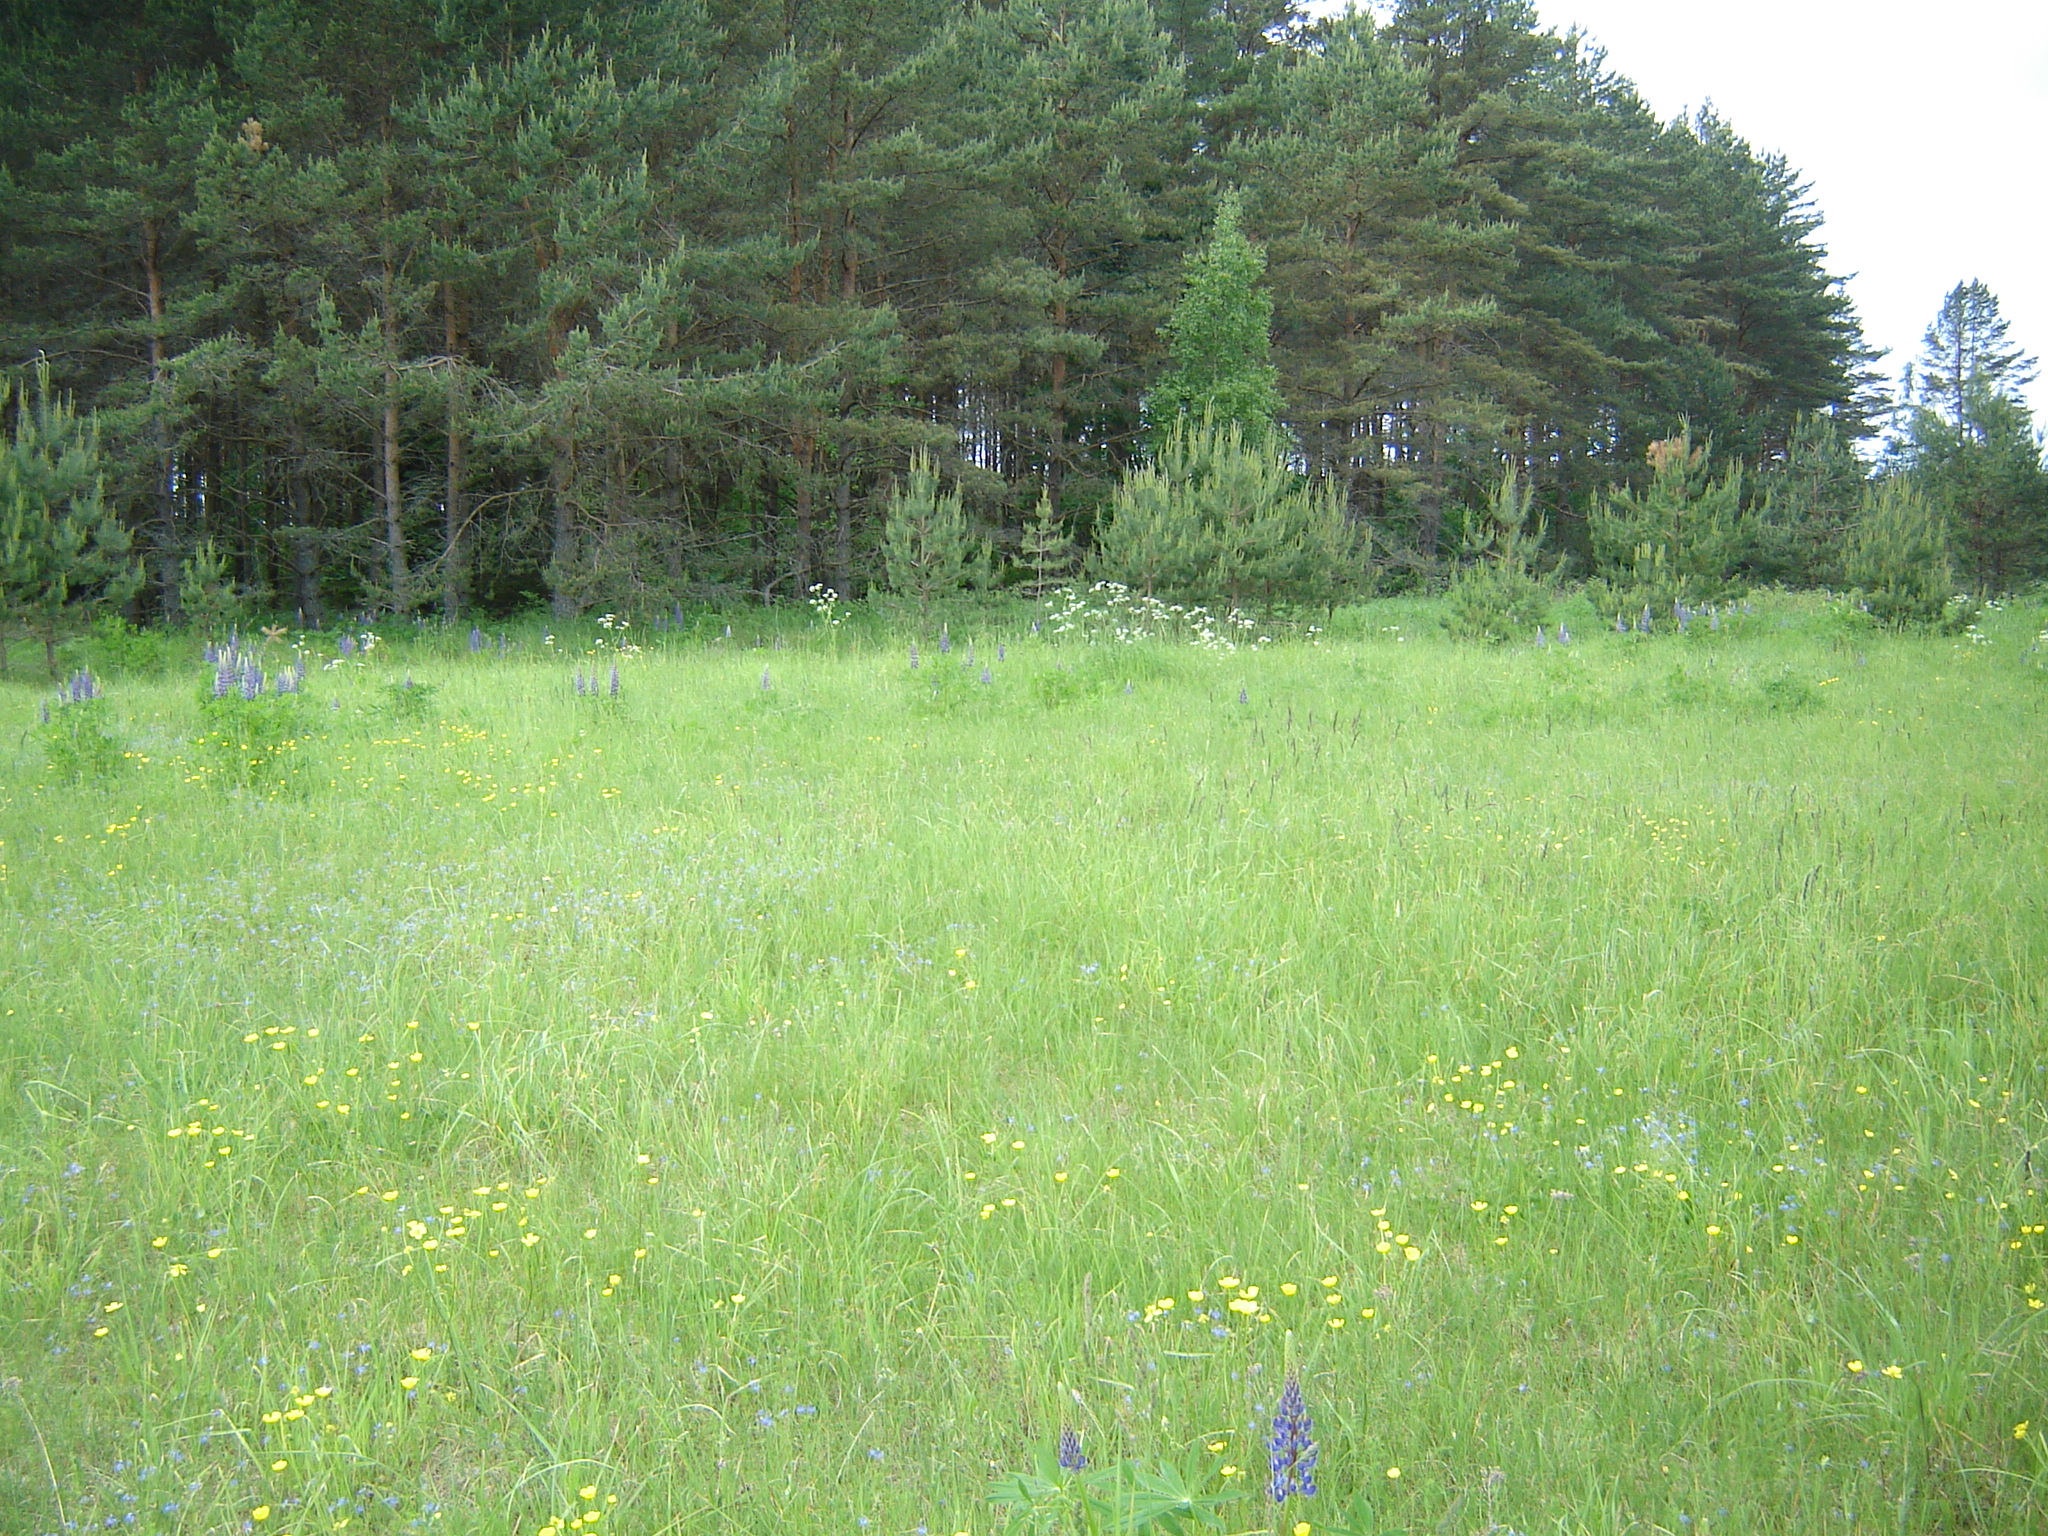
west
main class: Grassland
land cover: Grassland without tree/shrub cover
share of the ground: > 75 %
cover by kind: herbaceous plants 100 %
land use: Agriculture (excluding fallow land and kitchen gardens)
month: June
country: LT
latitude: 55.6350
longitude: 25.5496
